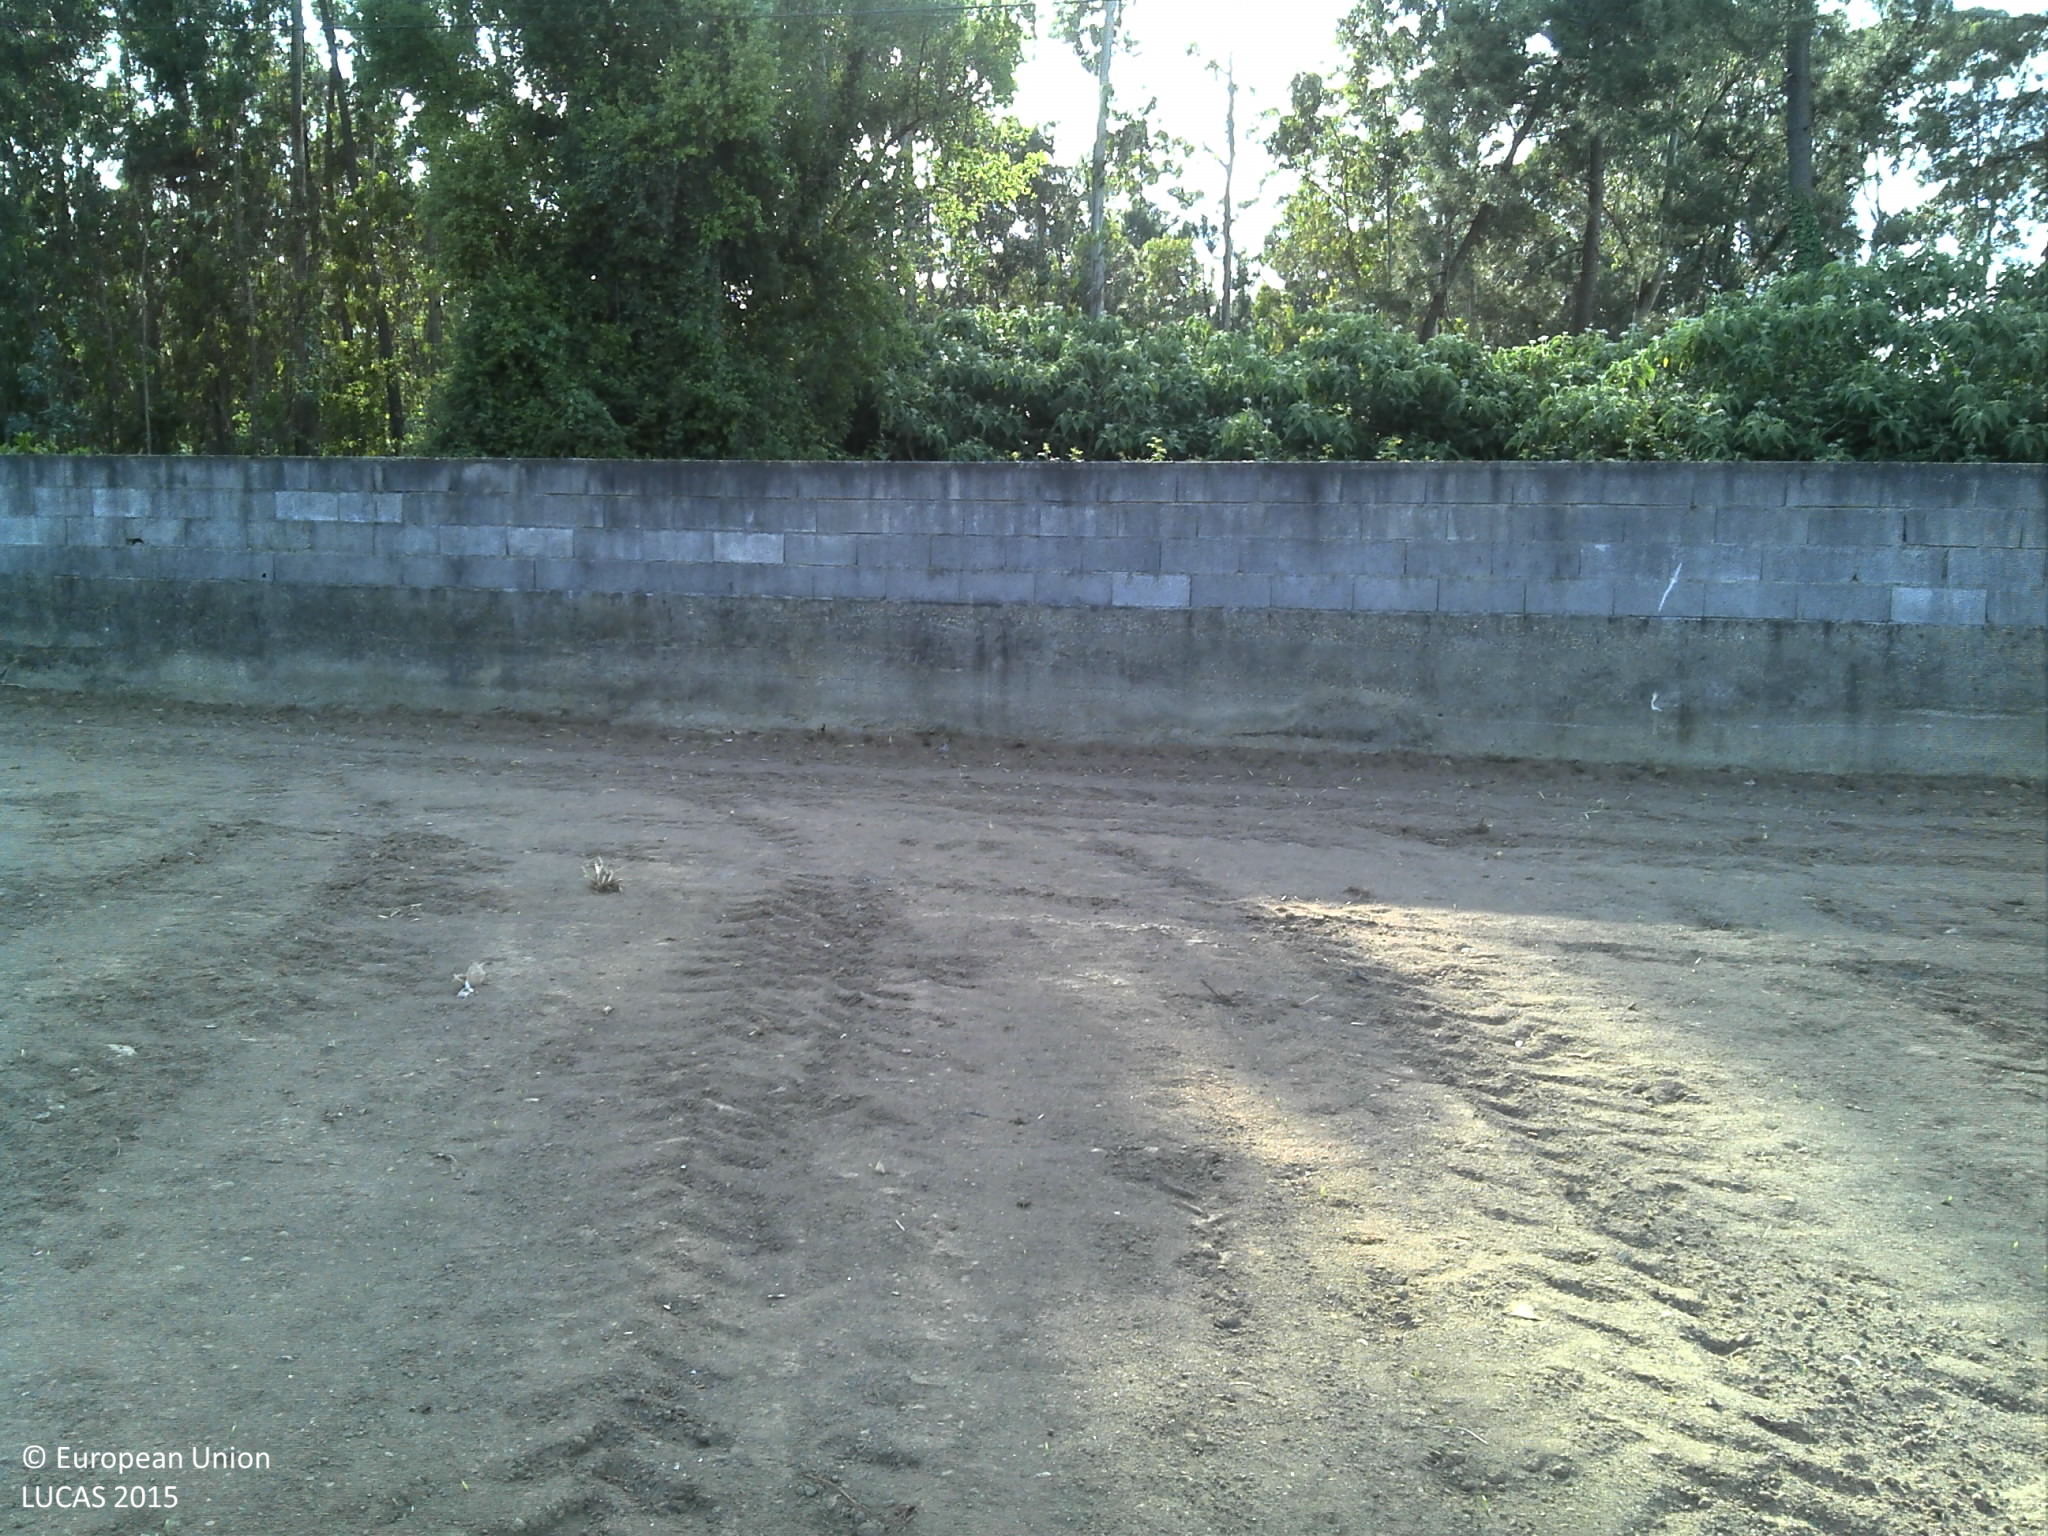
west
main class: Cropland
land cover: Maize
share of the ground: < 10 %
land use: Agriculture (excluding fallow land and kitchen gardens)
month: May
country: PT
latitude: 41.4136
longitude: -8.5924
